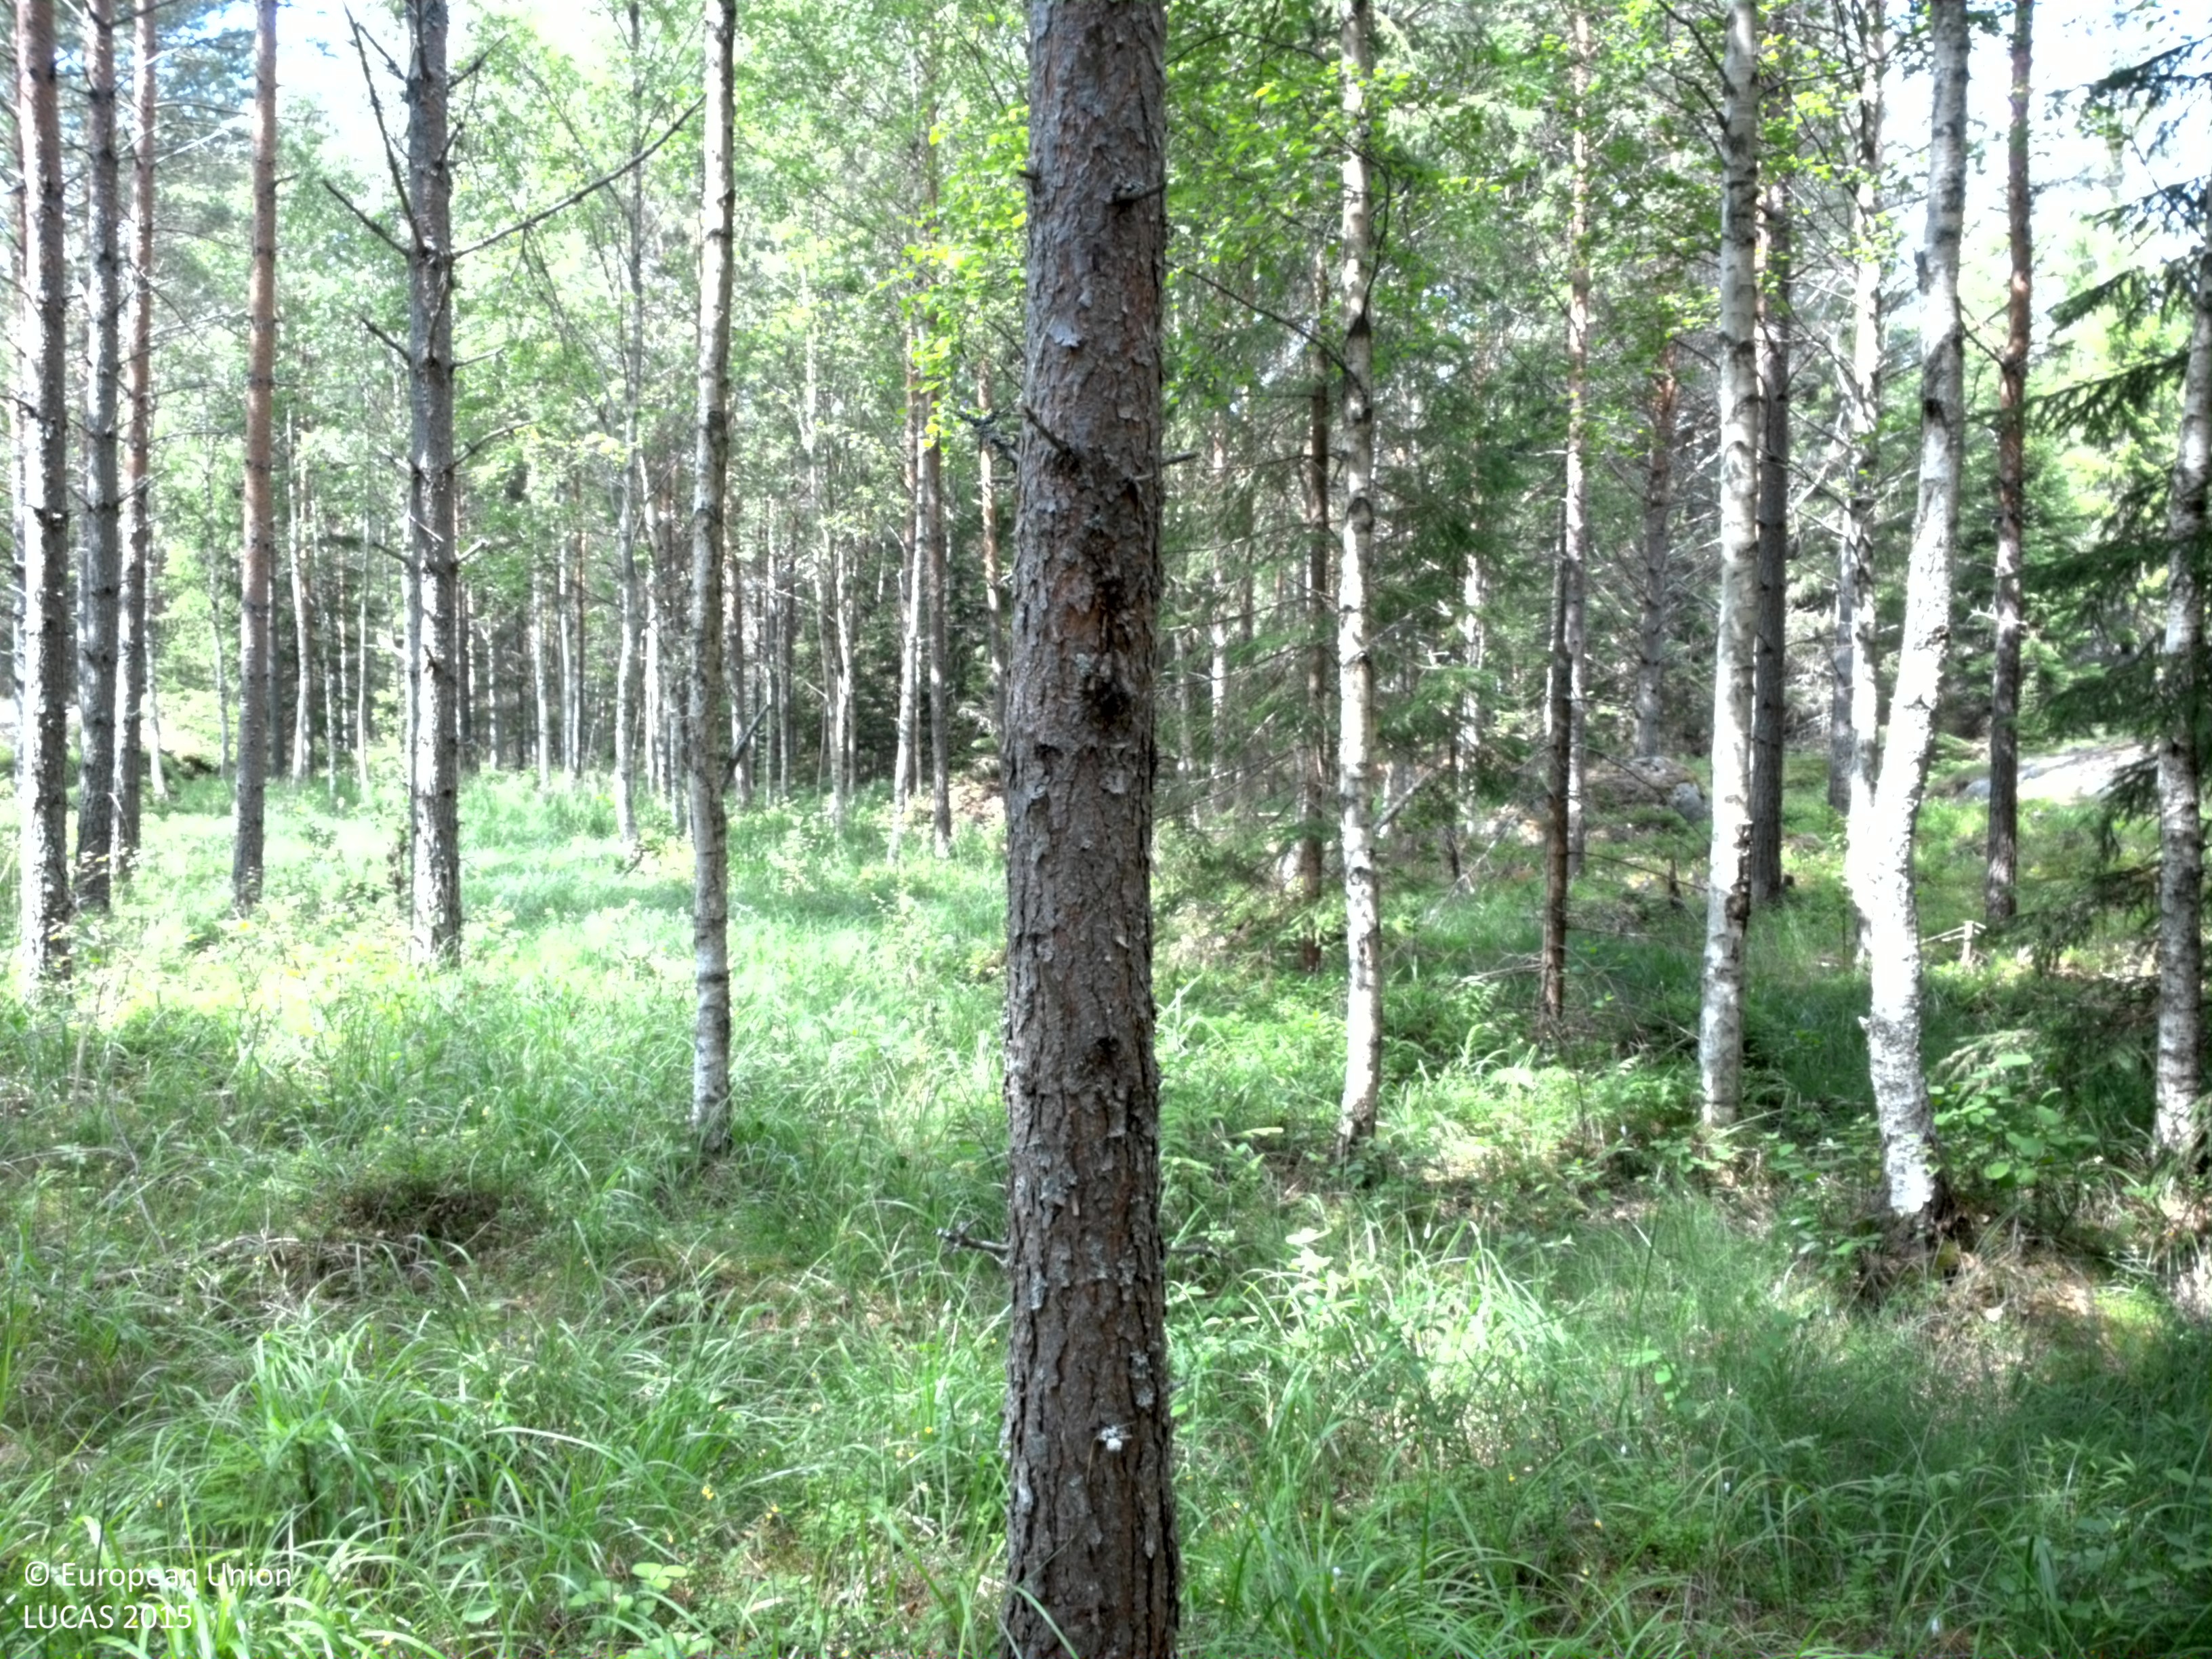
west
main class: Woodland
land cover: Pine dominated coniferous woodland
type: boreal forest
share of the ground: > 75 %
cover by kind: coniferous forest trees 70 %, shrubs 15 %, herbaceous plants 10 %, broadleaved forest trees 5 %
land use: Forestry
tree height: > 5 m
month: July
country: SE
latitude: 60.0047
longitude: 18.6600
